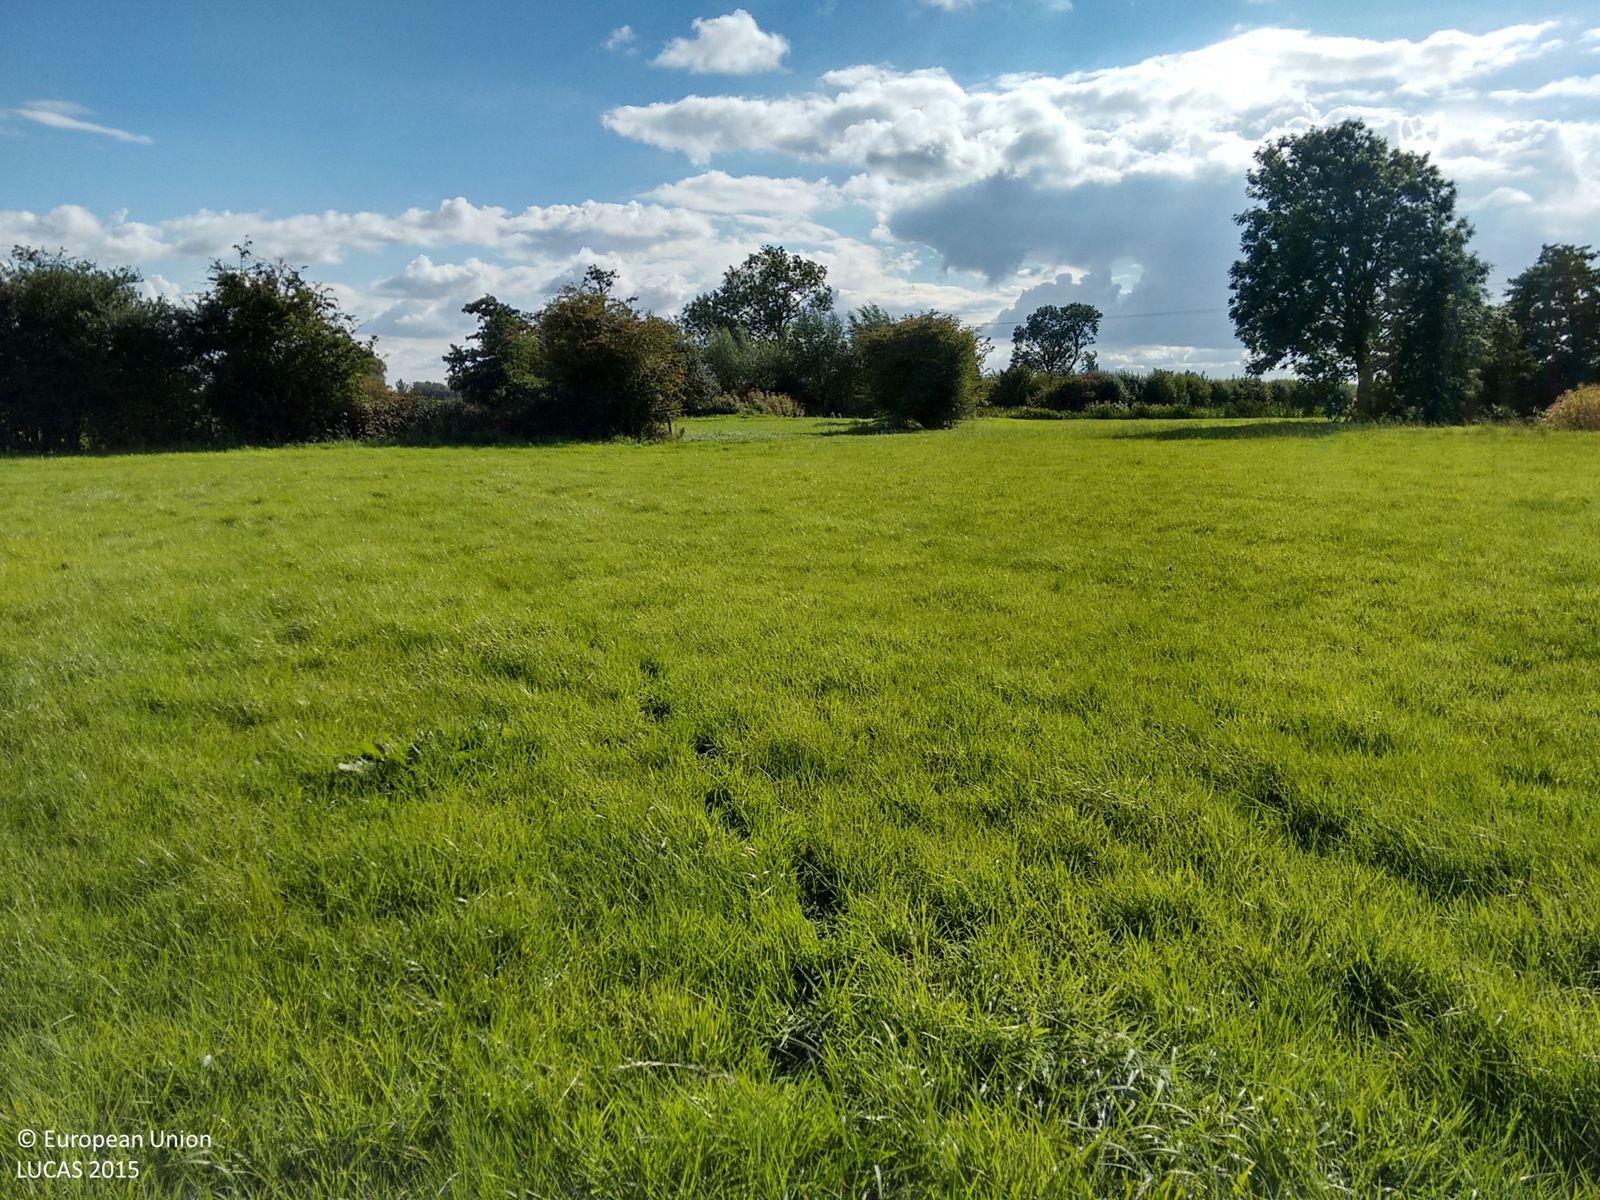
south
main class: Grassland
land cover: Grassland without tree/shrub cover
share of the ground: > 75 %
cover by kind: herbaceous plants 100 %
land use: Agriculture (excluding fallow land and kitchen gardens)
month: September
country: GB
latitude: 52.7643
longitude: -1.8375
